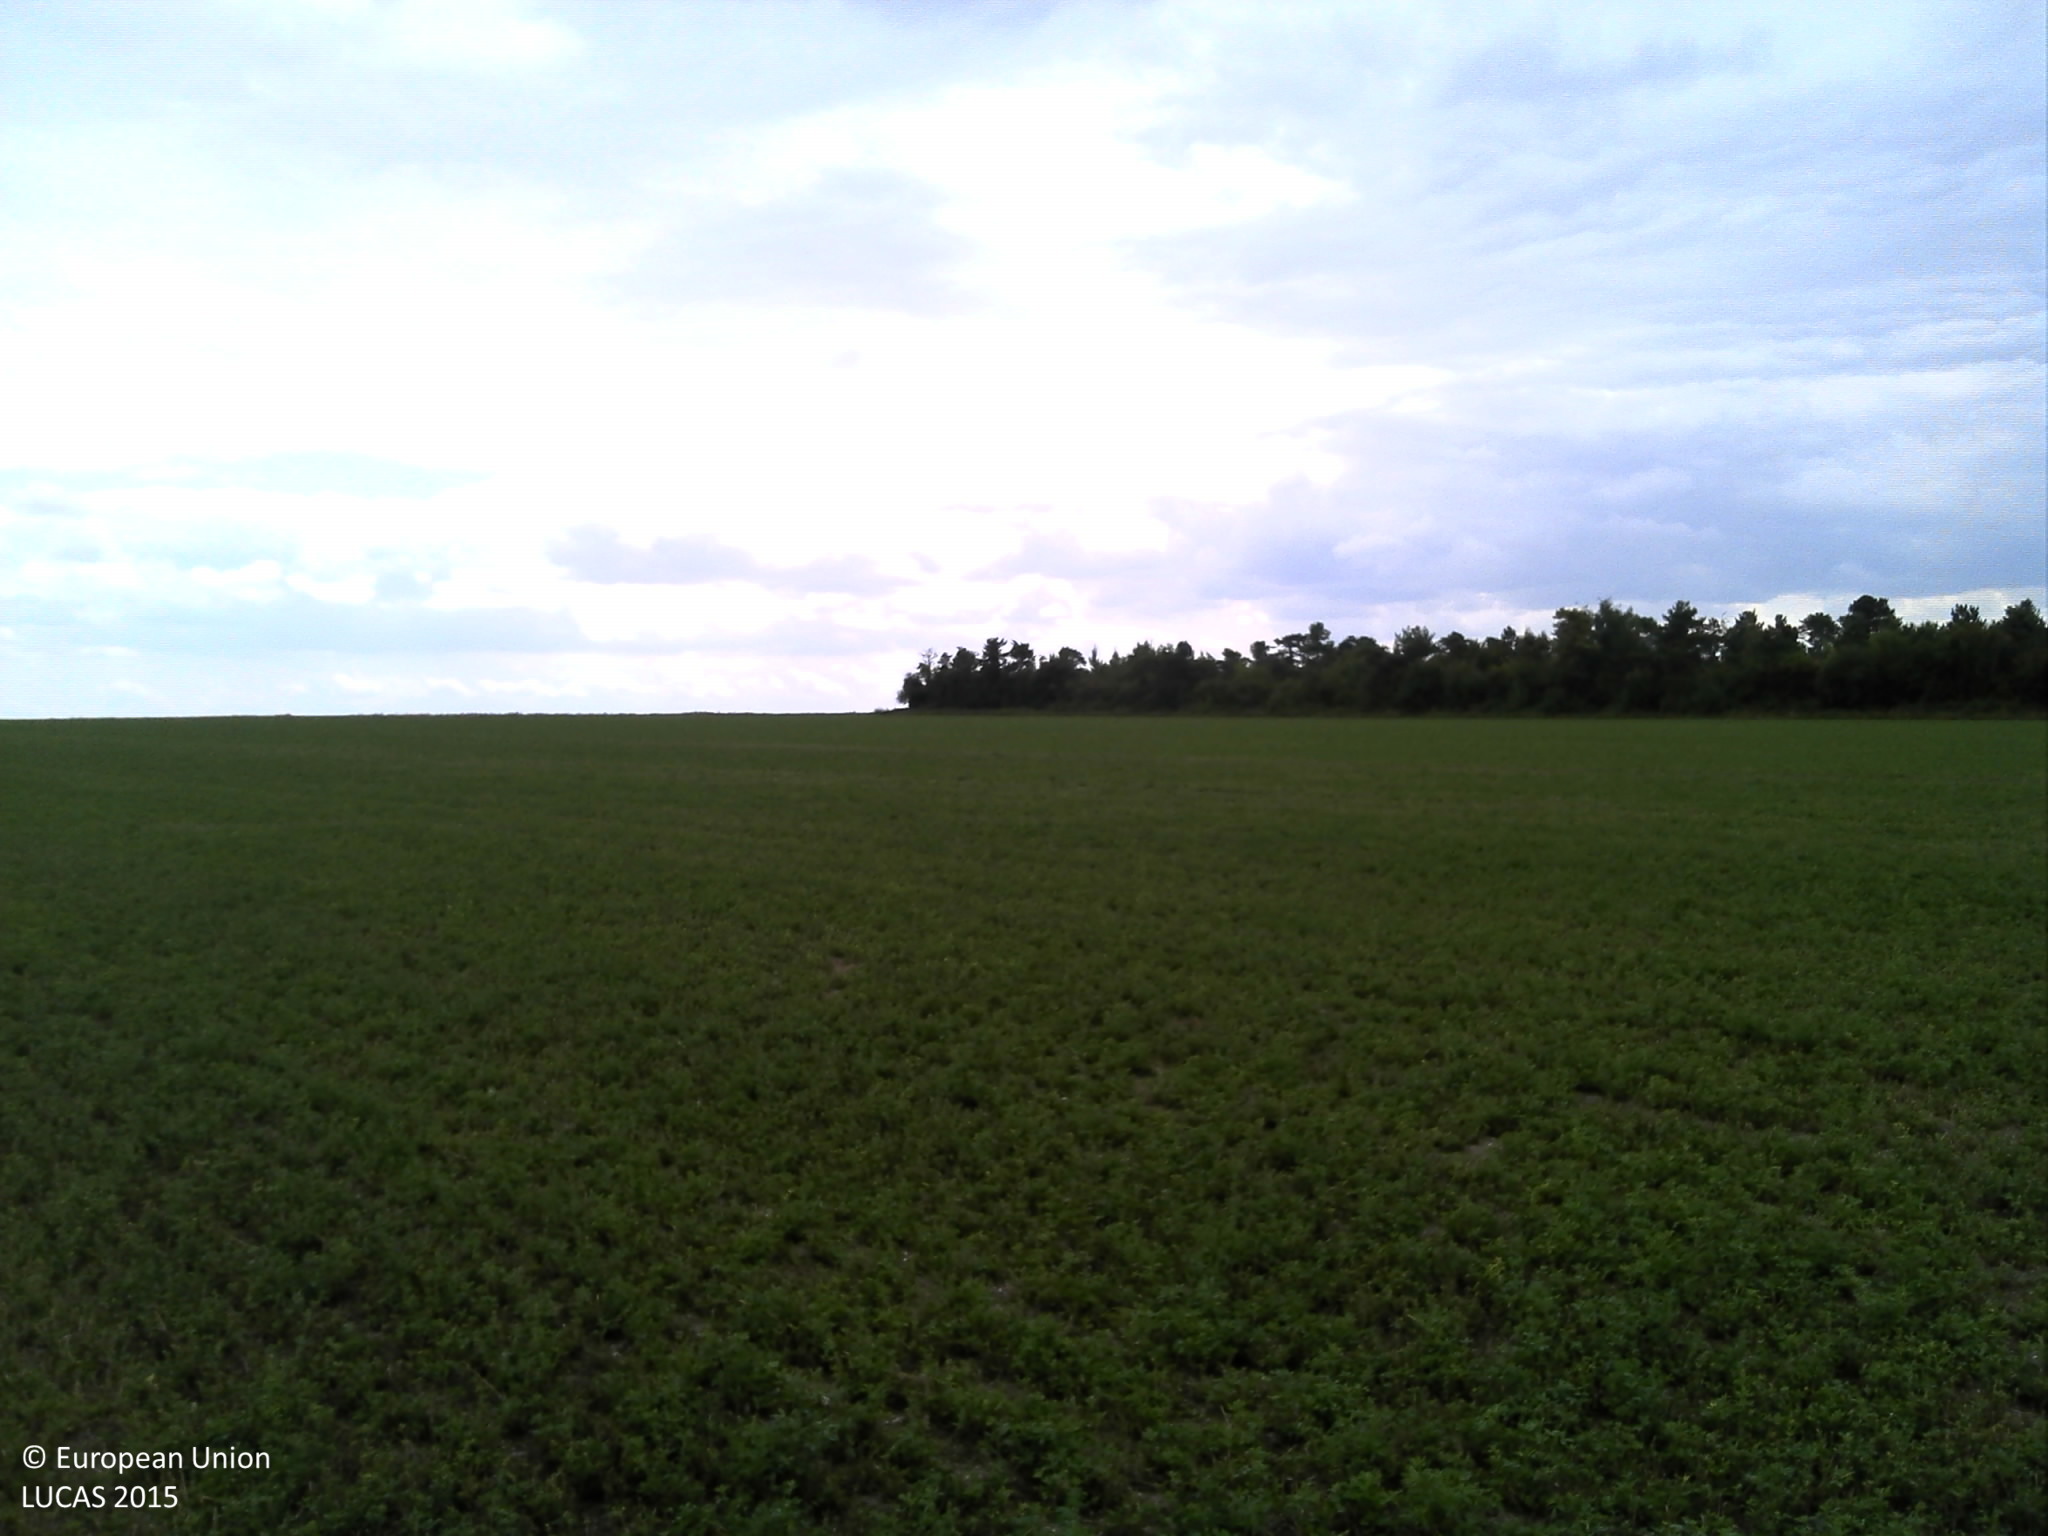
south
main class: Cropland
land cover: Lucerne
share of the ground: 50 - 75 %
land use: Agriculture (excluding fallow land and kitchen gardens)
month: August
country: FR
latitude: 48.4649
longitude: 3.8146
